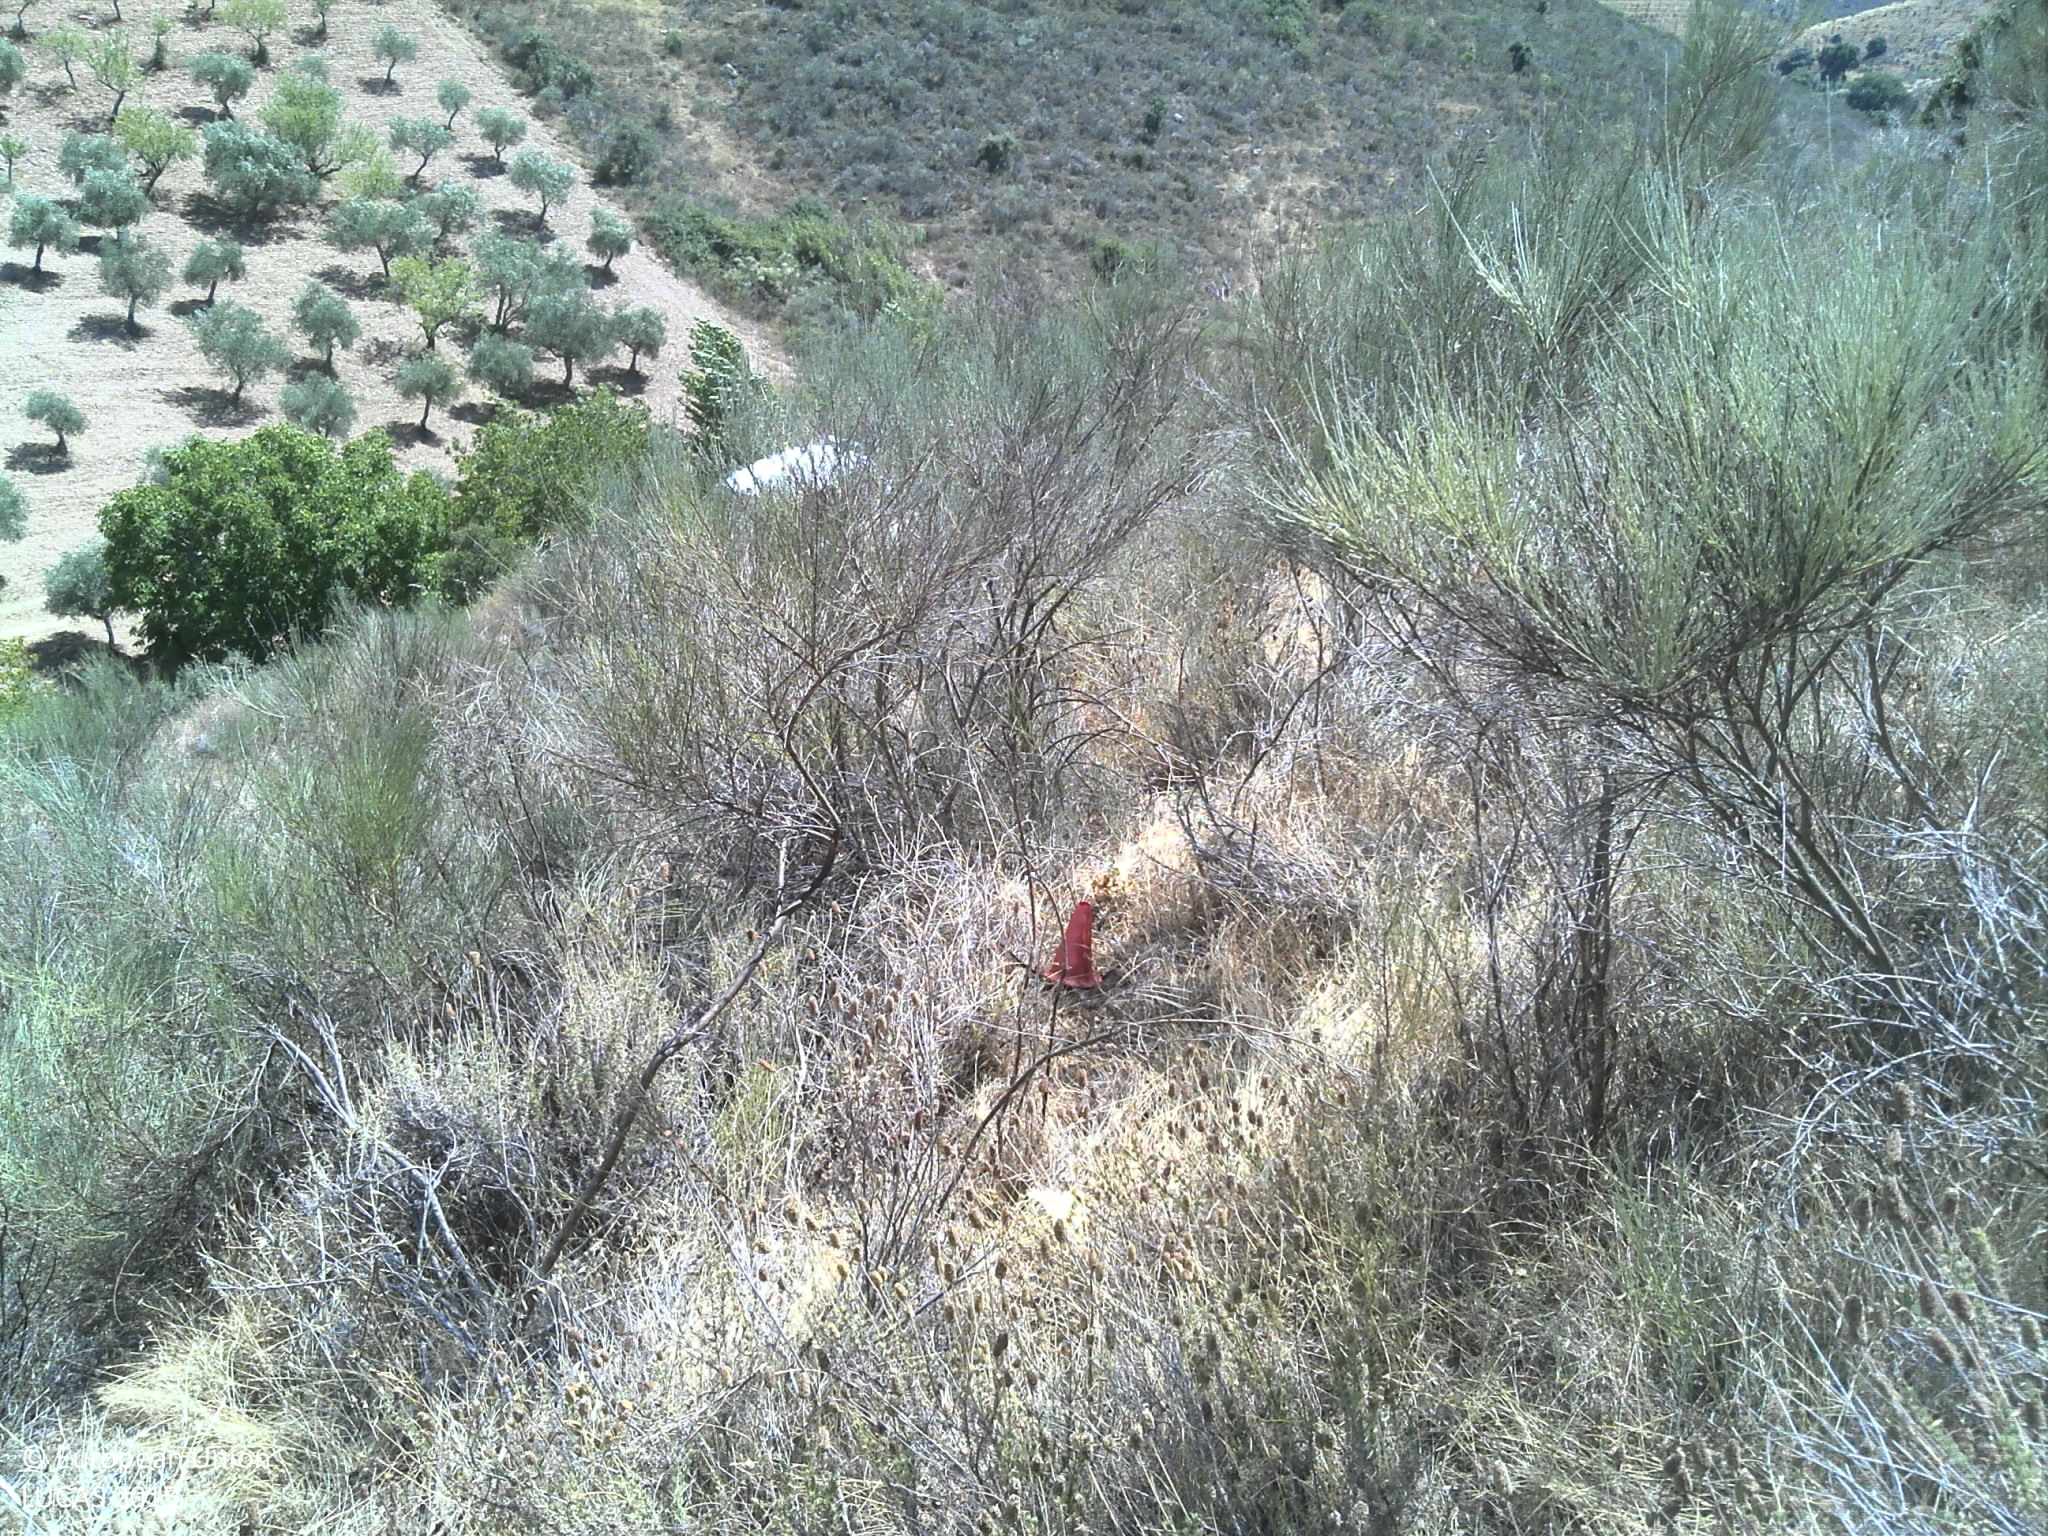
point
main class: Shrubland
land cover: Shrubland with sparse tree cover
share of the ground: > 75 %
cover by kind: shrubs 95 %, broadleaved forest trees 5 %
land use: Semi-natural and natural areas not in use
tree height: < 5 m
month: July
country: PT
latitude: 41.3517
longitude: -7.0008
